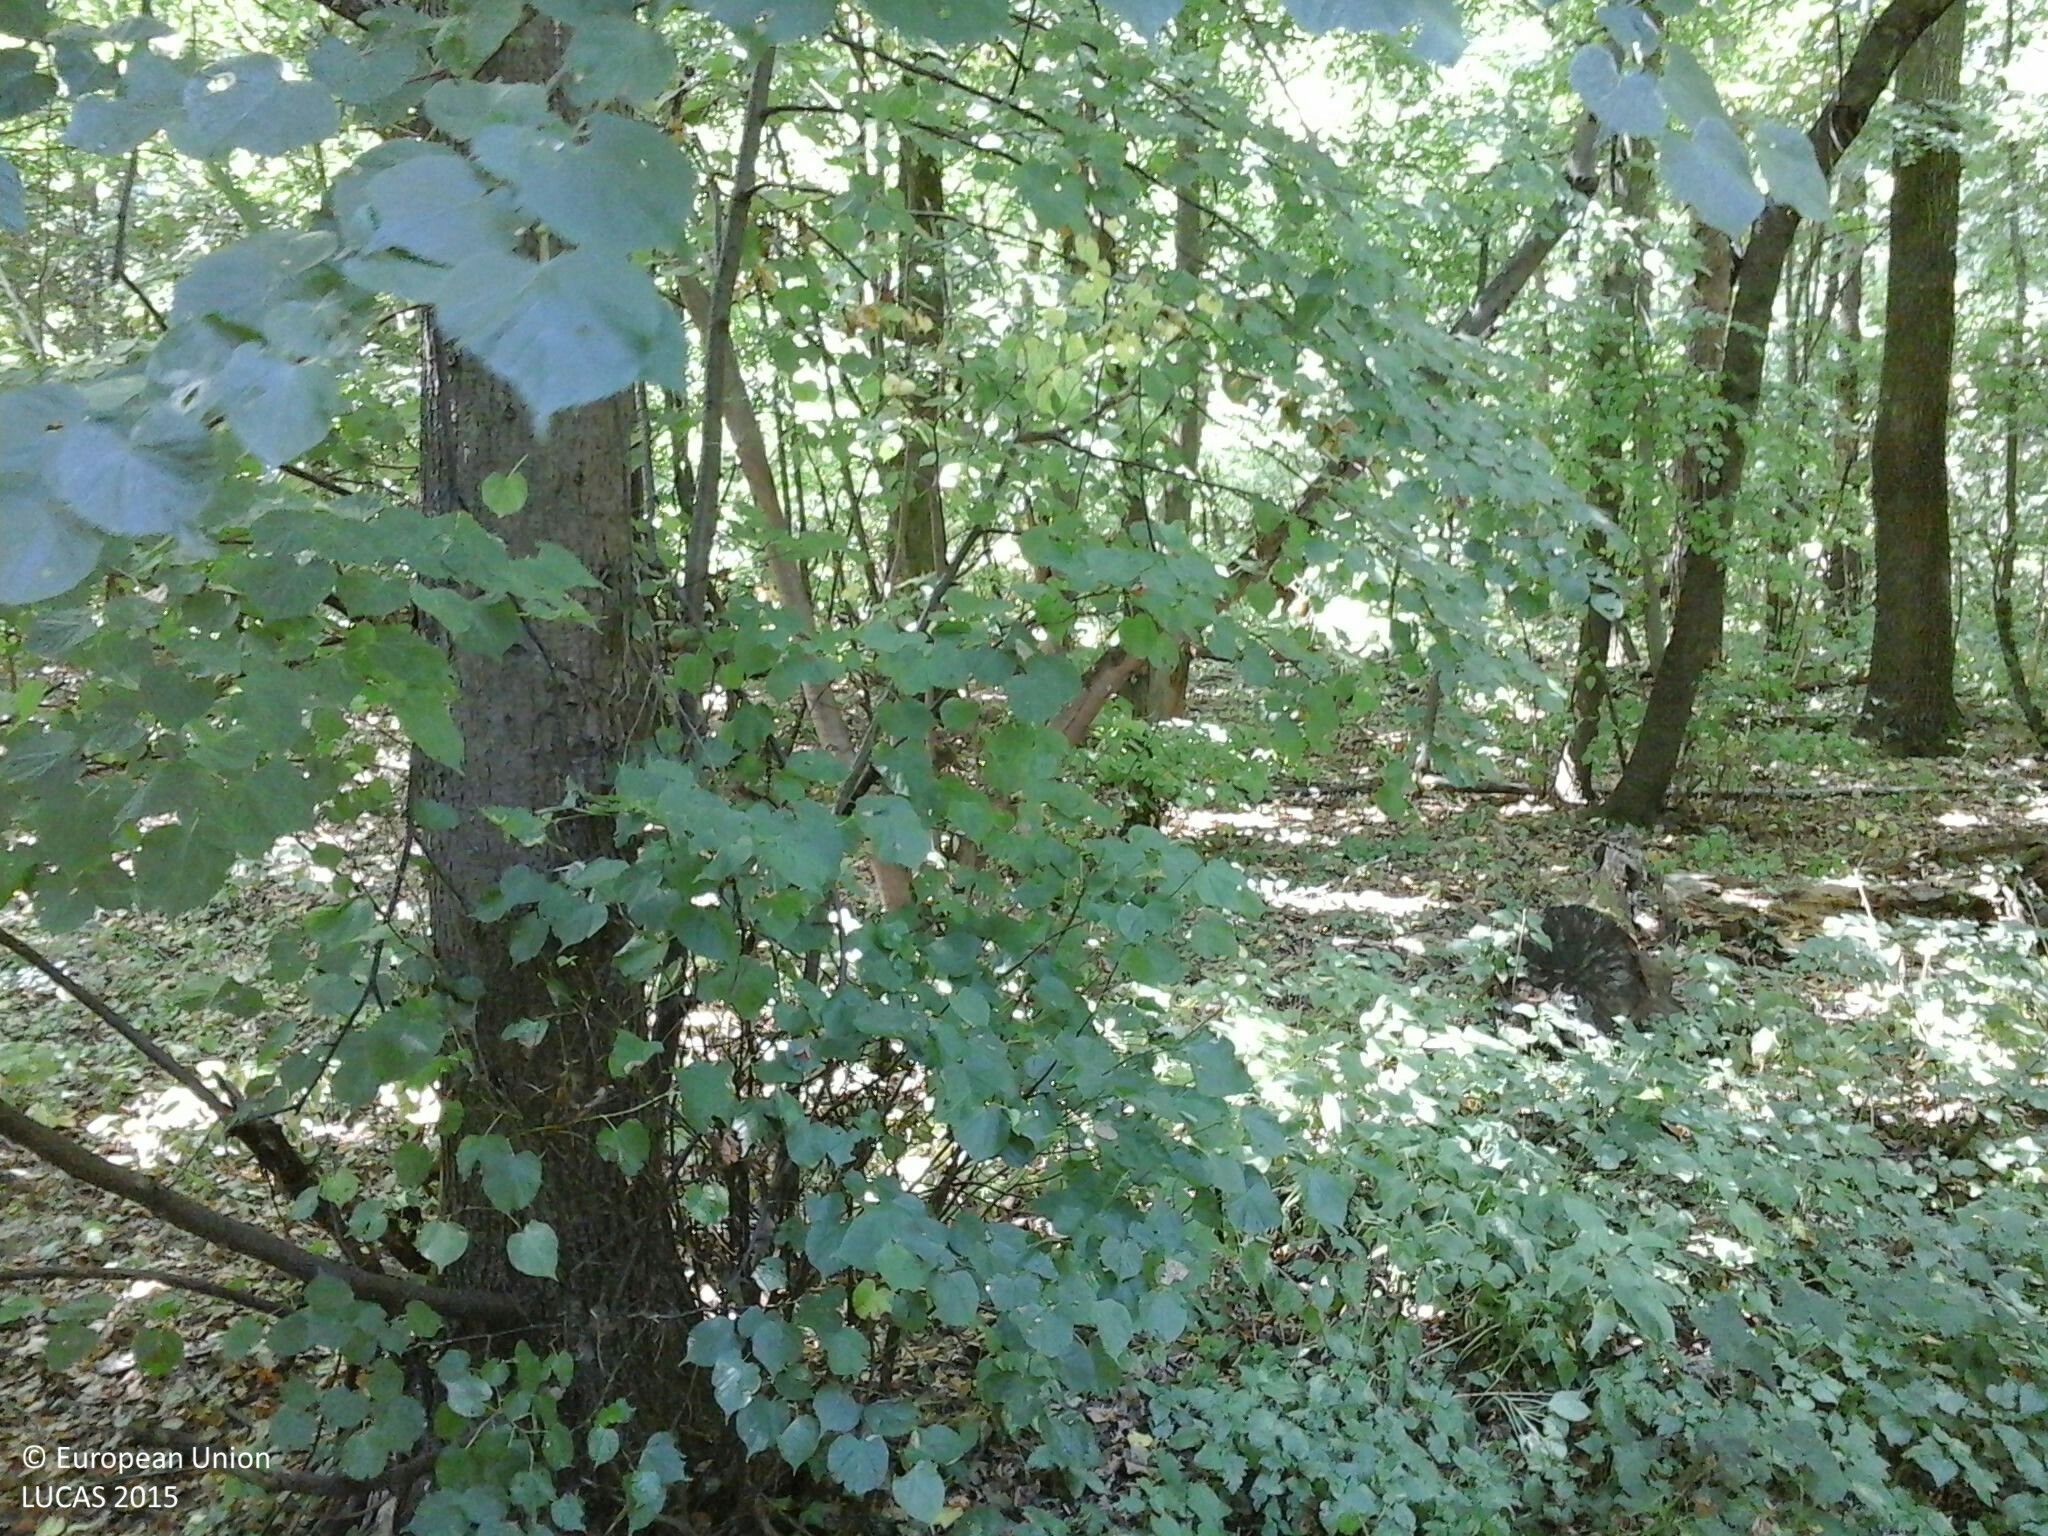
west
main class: Woodland
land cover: Broadleaved woodland
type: mesophytic deciduous forest
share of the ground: > 75 %
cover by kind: broadleaved forest trees 80 %, shrubs 20 %
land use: Forestry
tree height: > 5 m
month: July
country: HU
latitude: 46.9937
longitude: 16.6435
